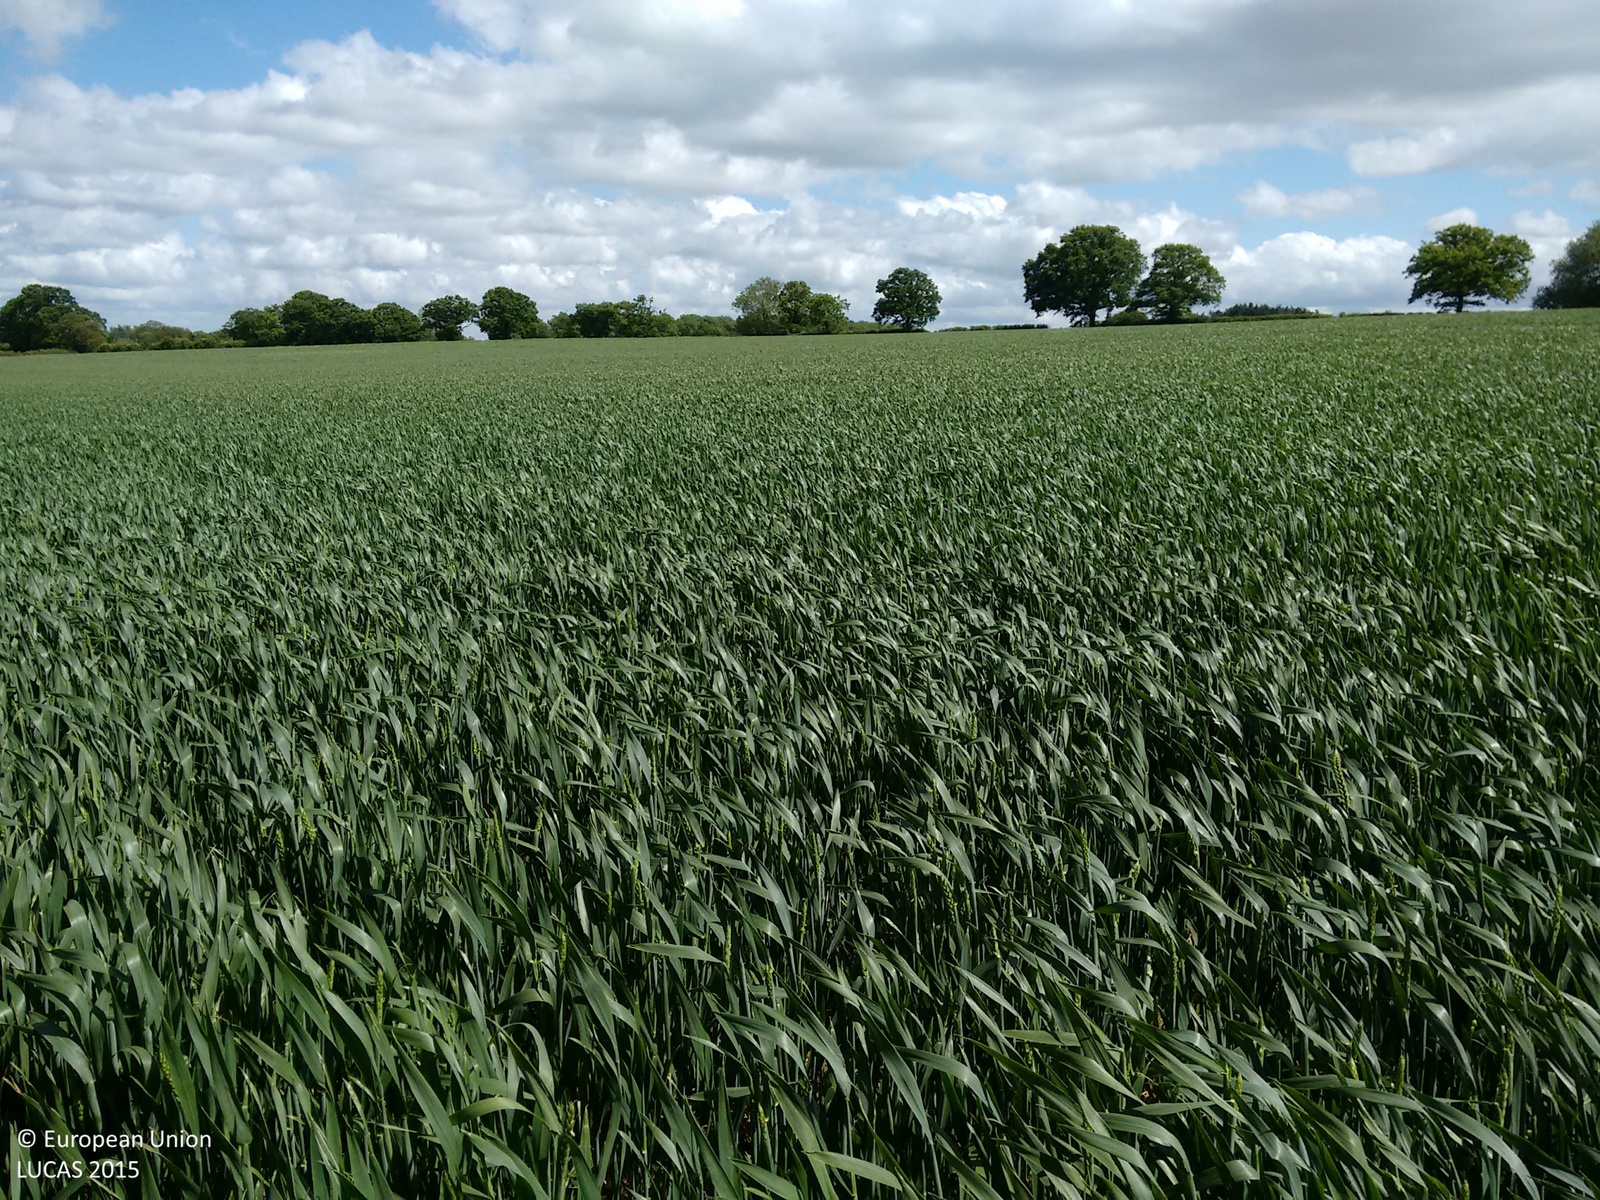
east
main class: Cropland
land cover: Common wheat
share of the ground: > 75 %
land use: Agriculture (excluding fallow land and kitchen gardens)
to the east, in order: Grass margins; Common wheat
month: June
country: GB
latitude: 52.5041
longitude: -1.5277
